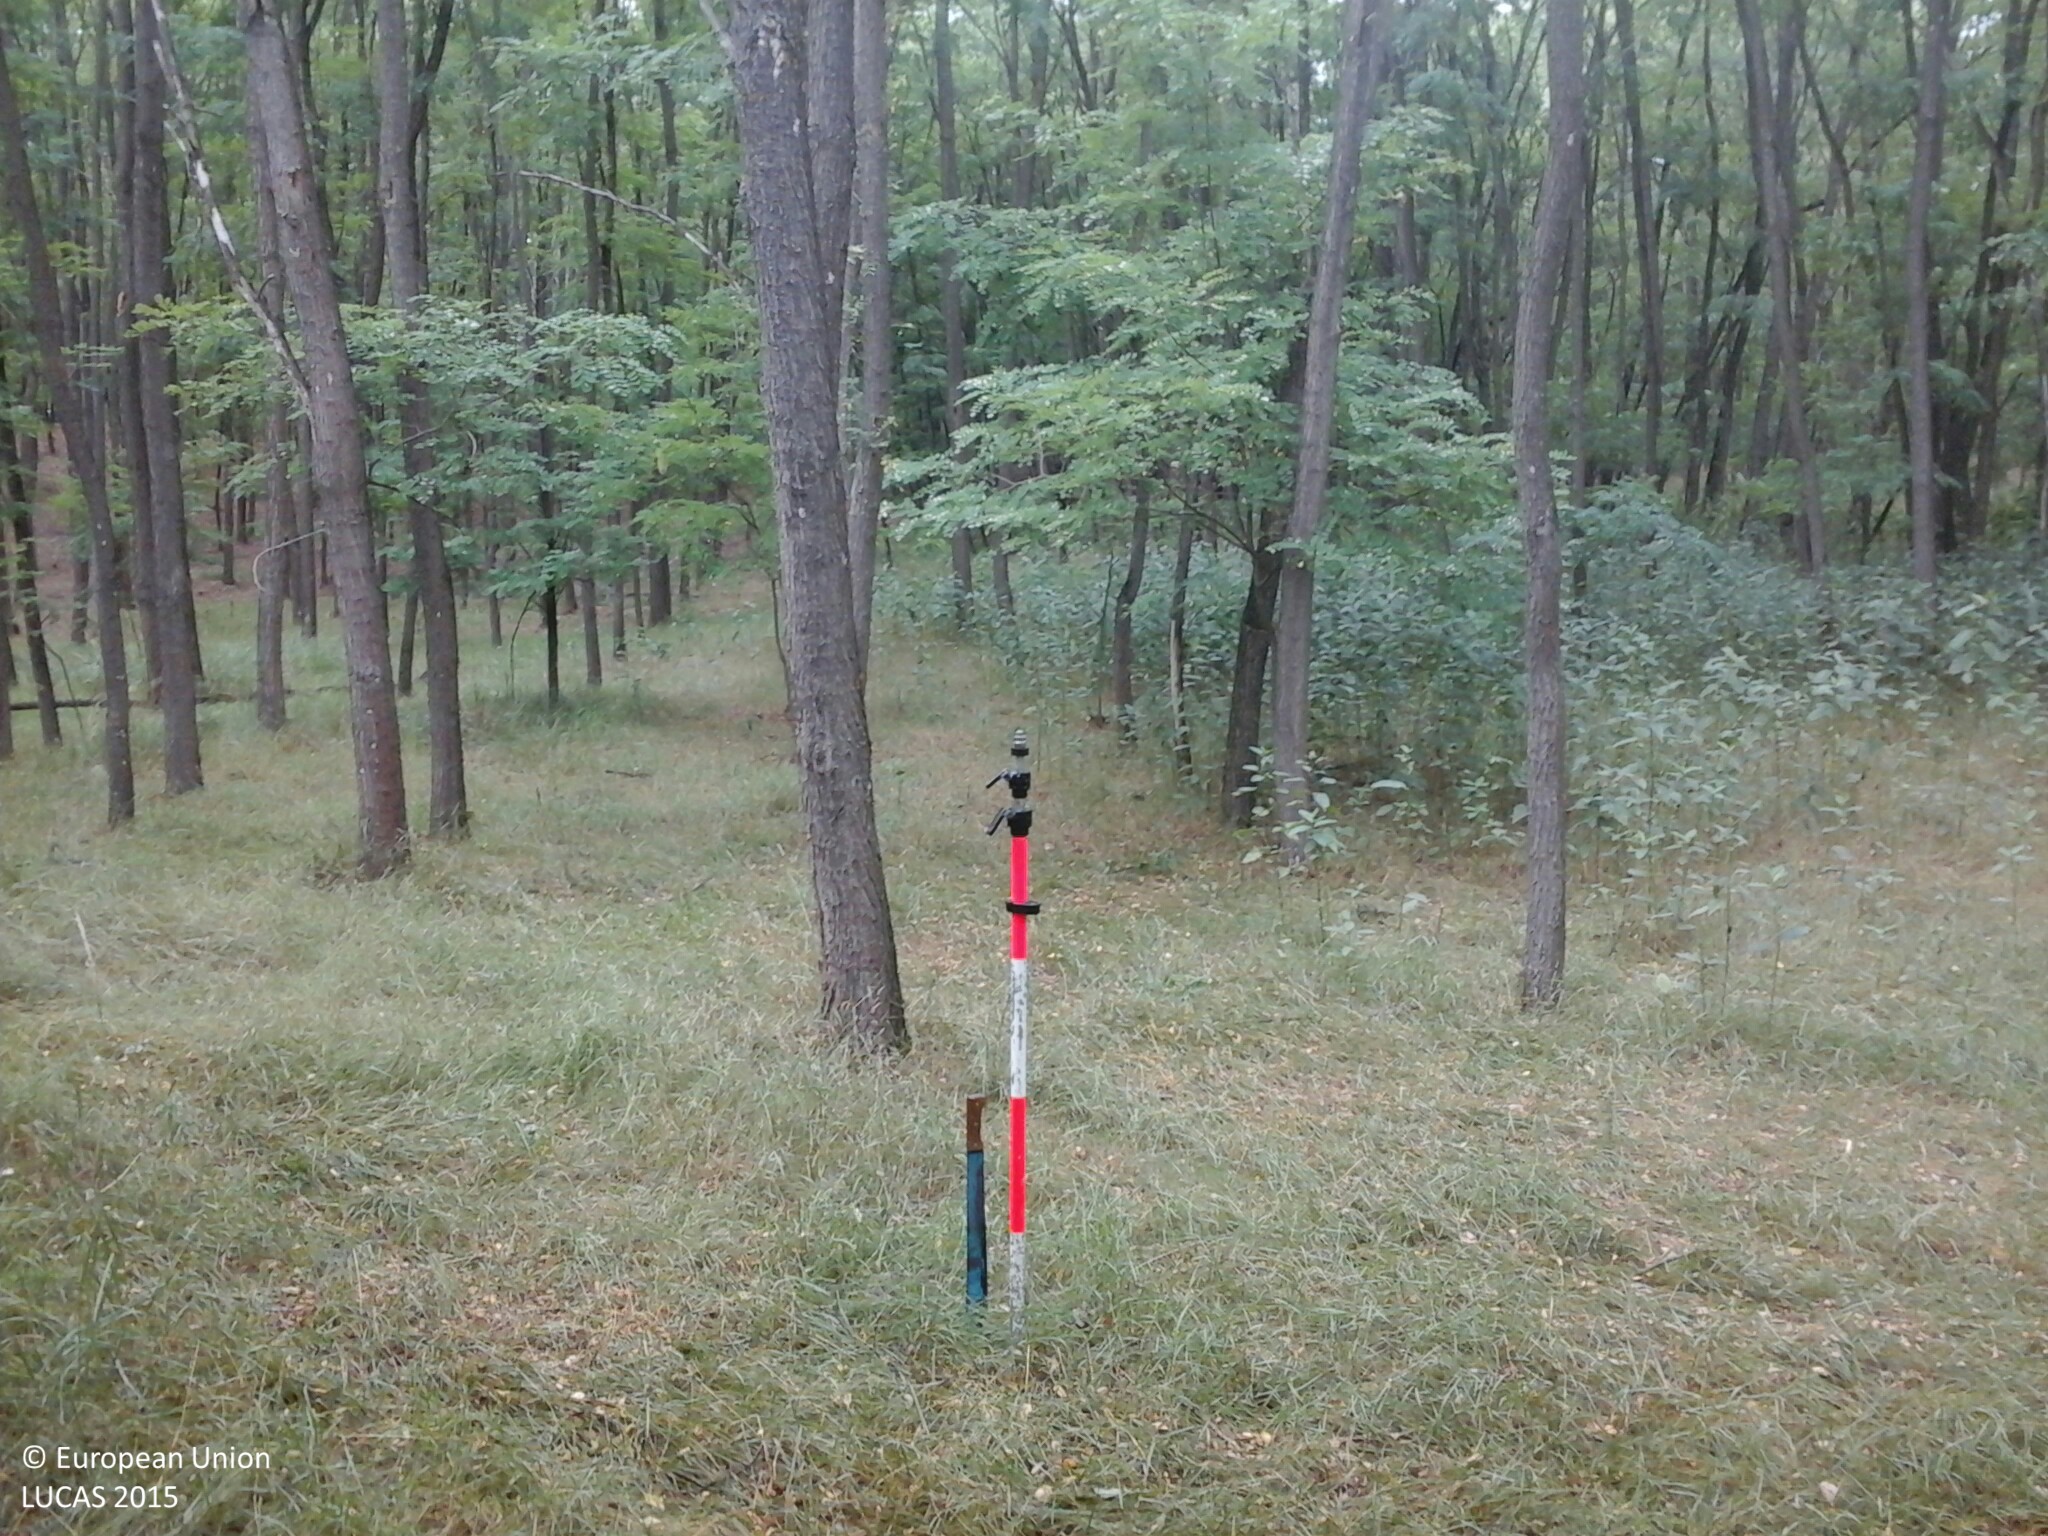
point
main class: Woodland
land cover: Broadleaved woodland
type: exotic forest
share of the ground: > 75 %
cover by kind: broadleaved forest trees 95 %, herbaceous plants 5 %
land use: Forestry
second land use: Agriculture (excluding fallow land and kitchen gardens)
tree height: > 5 m
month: July
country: HU
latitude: 48.1768
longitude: 22.2271
